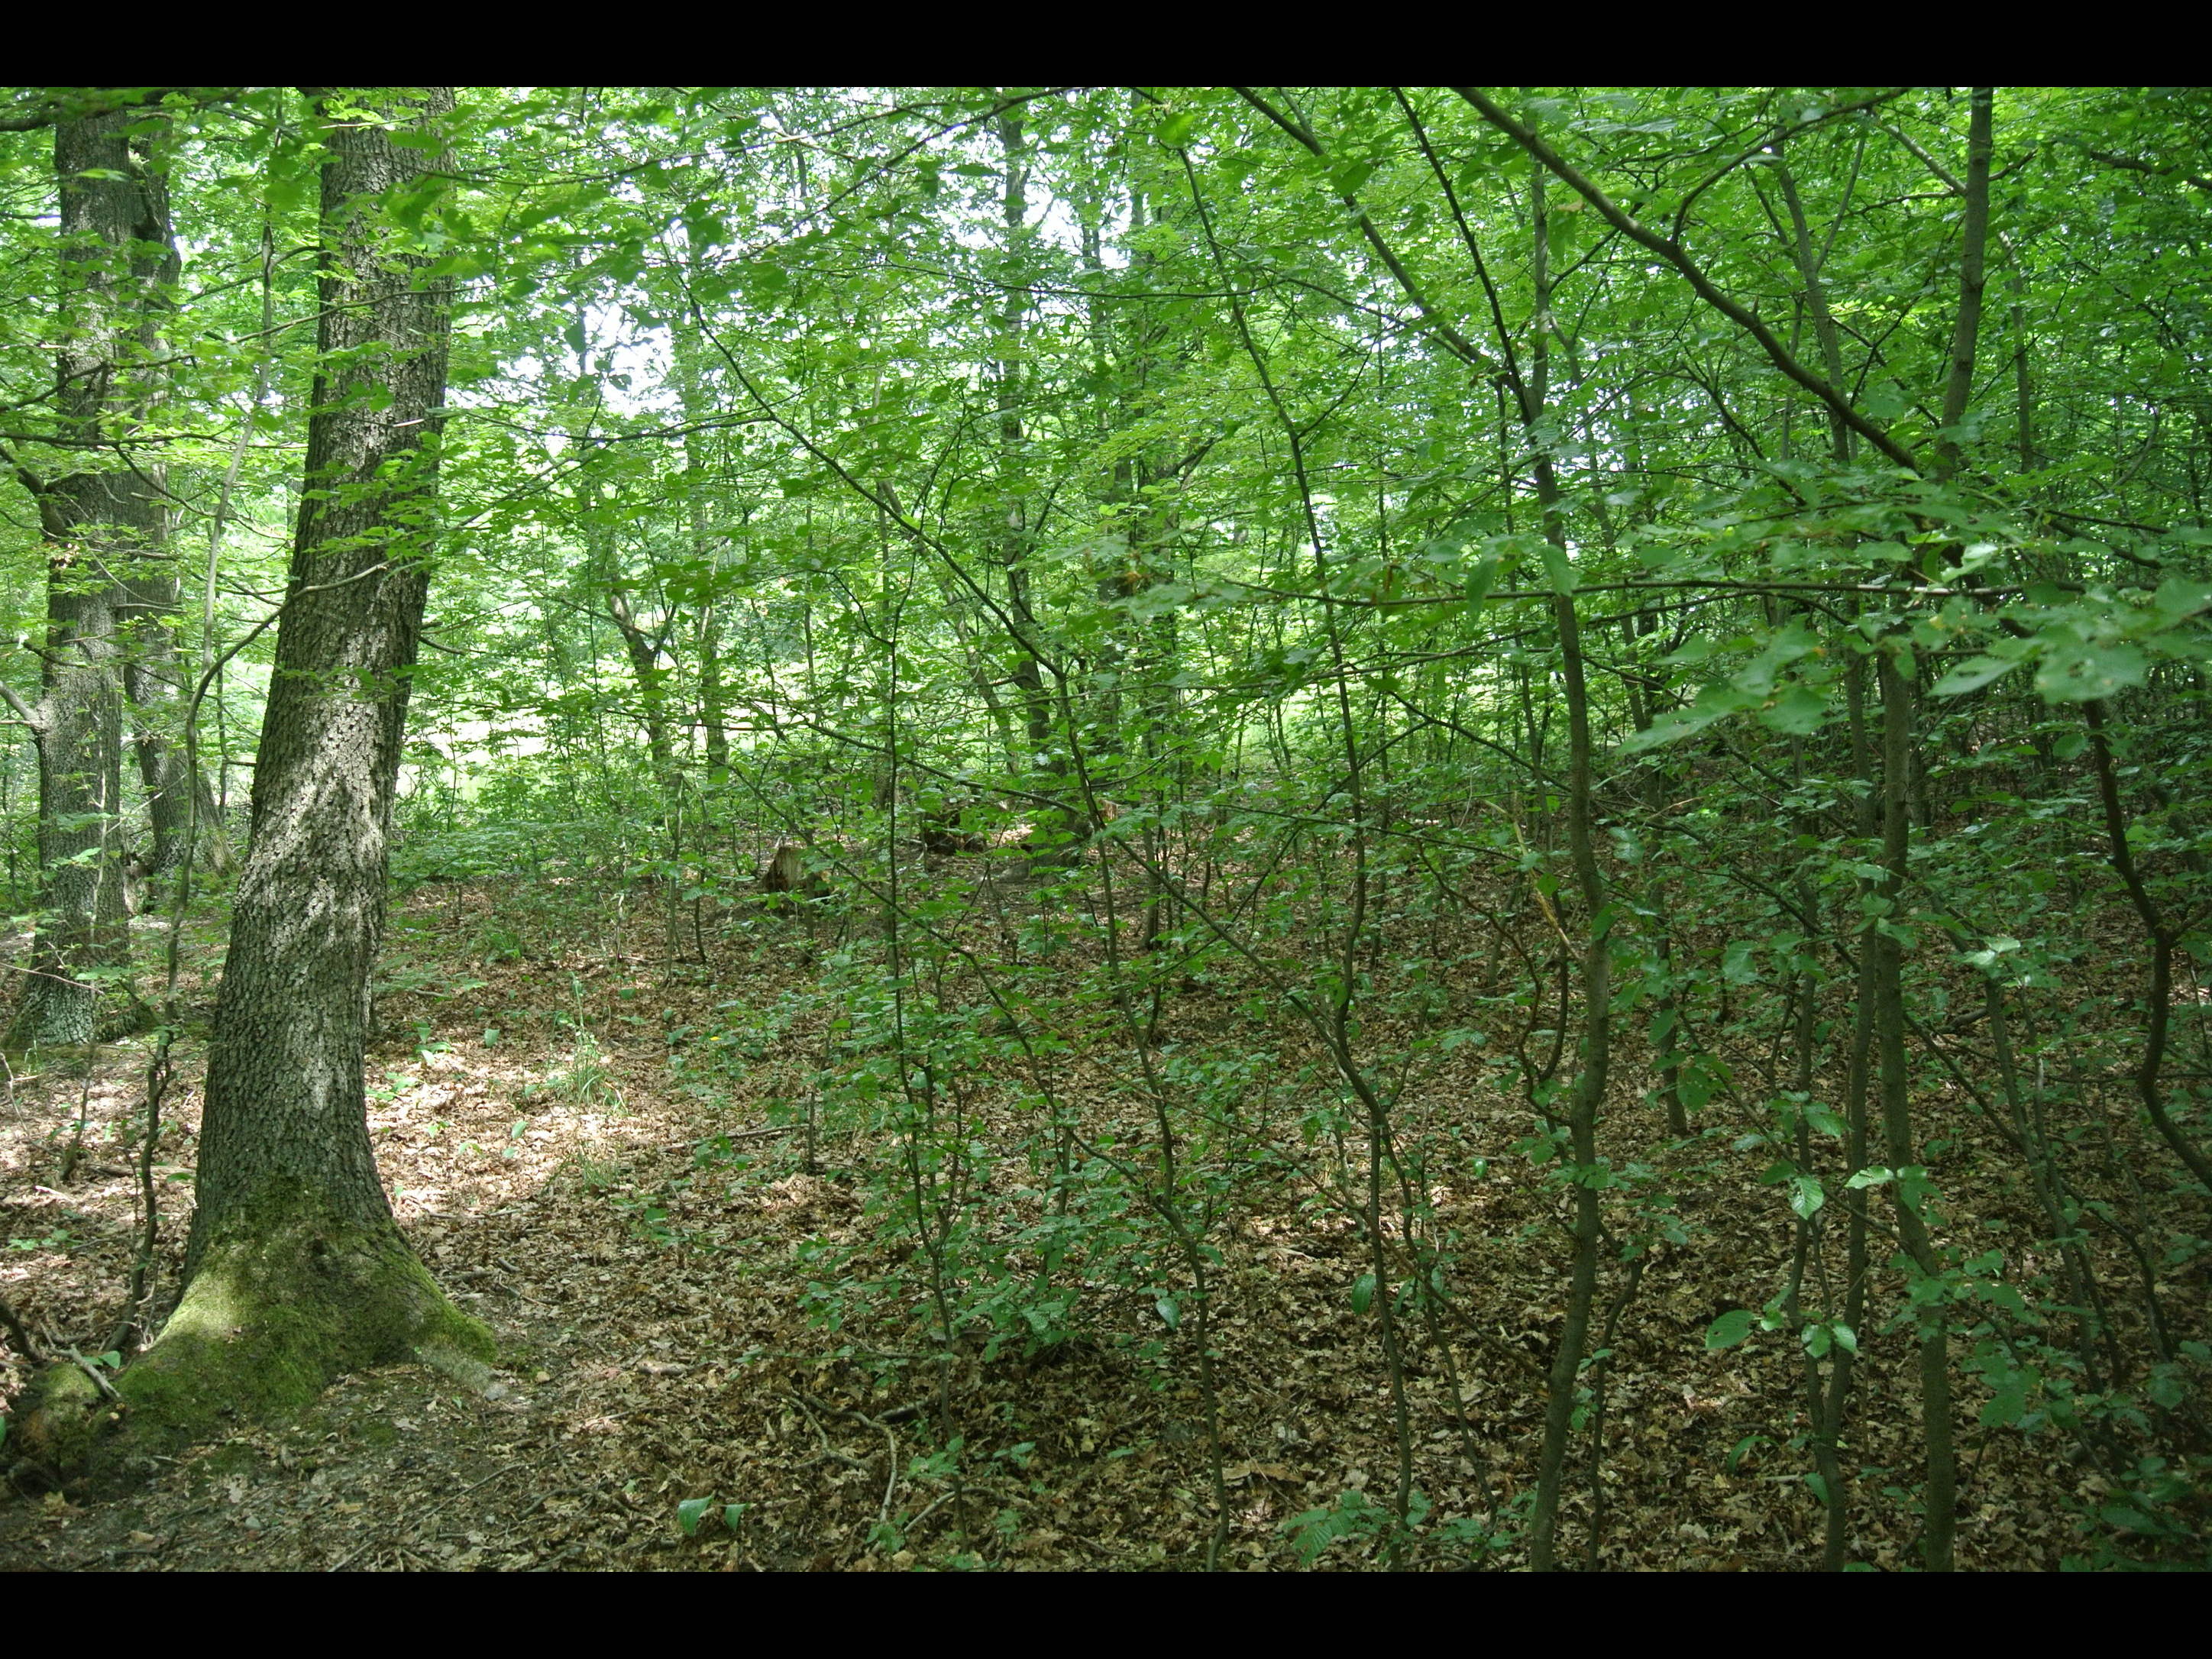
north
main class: Woodland
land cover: Broadleaved woodland
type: beech forest
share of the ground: > 75 %
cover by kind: broadleaved forest trees 95 %, unconsolidated bare surface 5 %
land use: Forestry
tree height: > 5 m
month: June
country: AT
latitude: 47.8993
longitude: 16.5999
